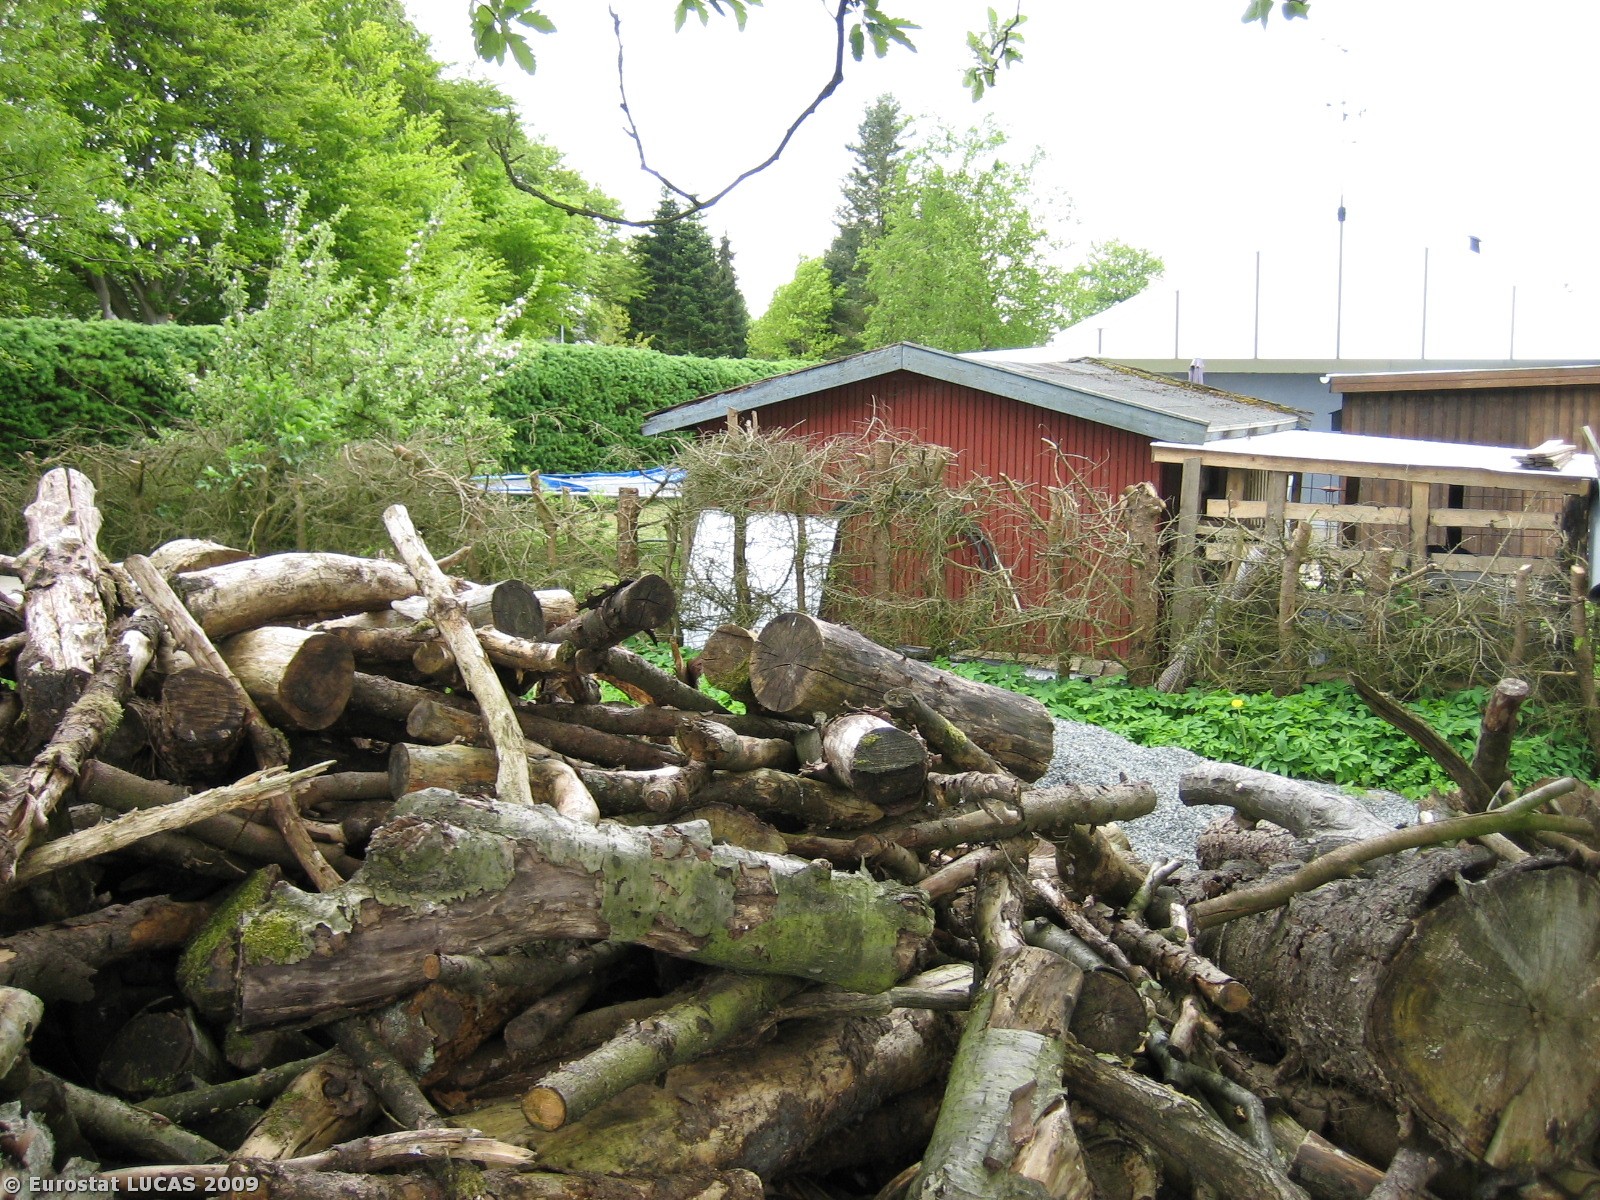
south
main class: Woodland
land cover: Broadleaved woodland
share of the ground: 50 - 75 %
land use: Unused
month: May
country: DK
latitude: 56.1794
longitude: 8.5357
